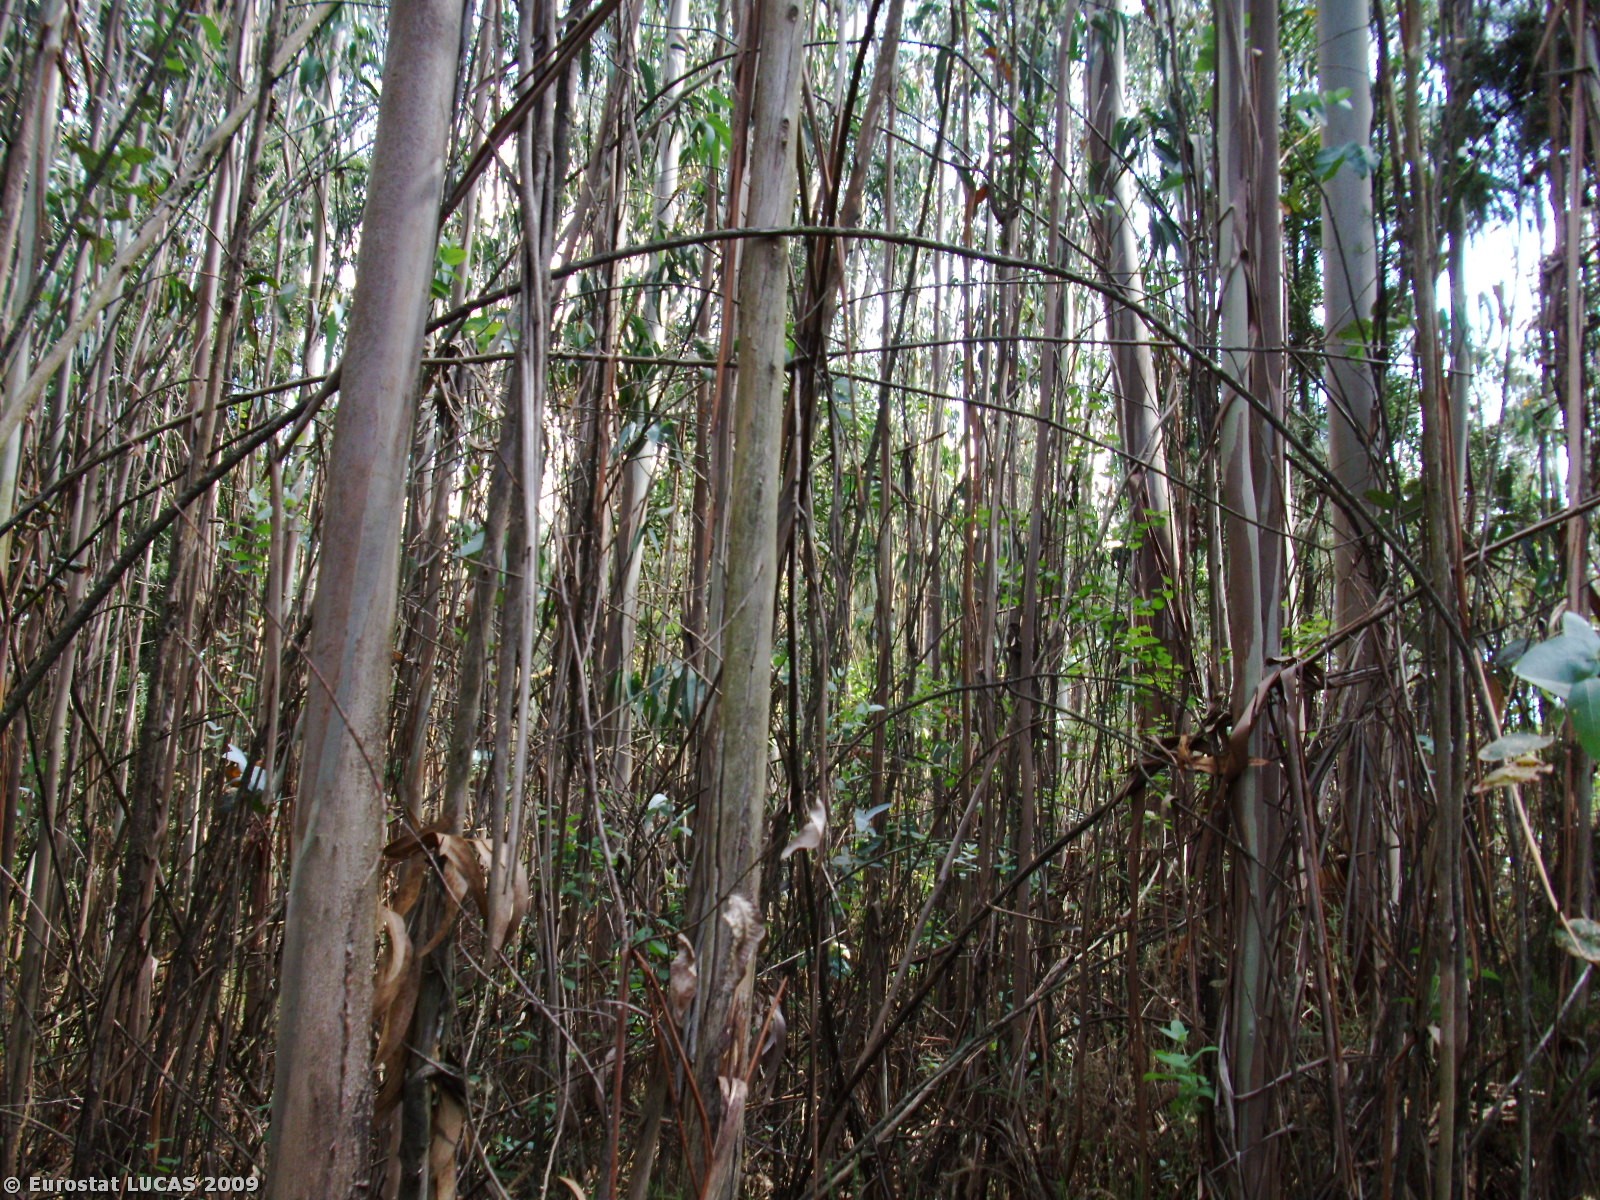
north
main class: Woodland
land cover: Broadleaved woodland
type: plantations and self-sown exotic forest
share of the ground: 50 - 75 %
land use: Forestry
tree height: > 5 m
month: July
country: PT
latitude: 41.2128
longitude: -8.4816
